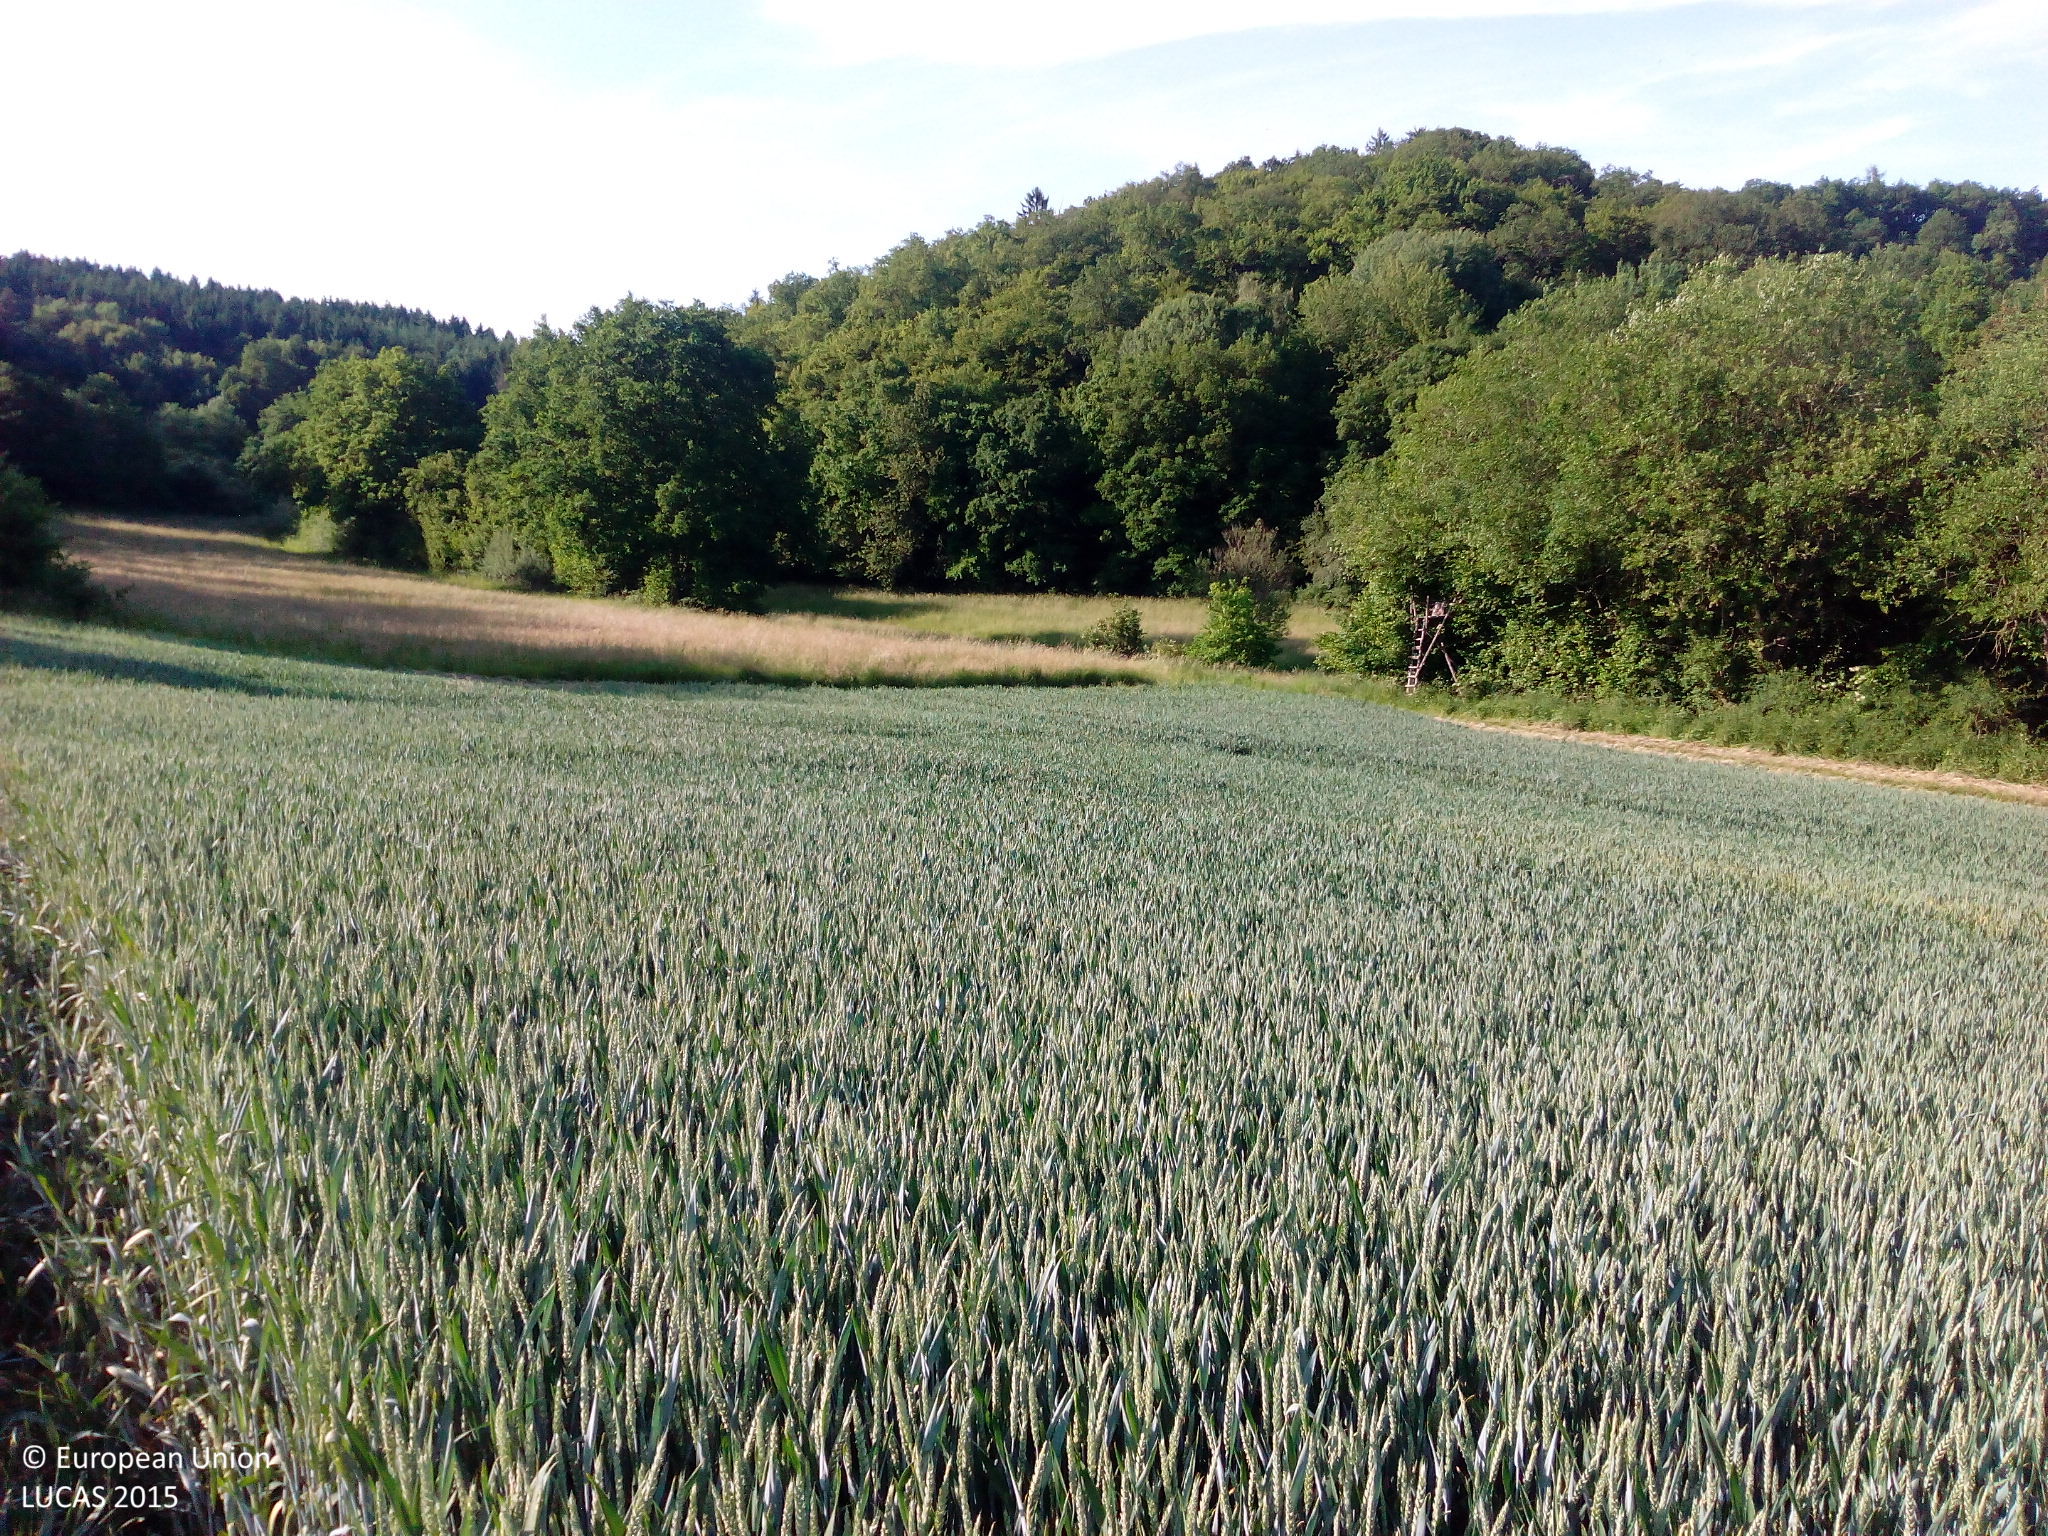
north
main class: Cropland
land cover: Common wheat
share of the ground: > 75 %
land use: Agriculture (excluding fallow land and kitchen gardens)
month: June
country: DE
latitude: 50.1511
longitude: 8.1390
